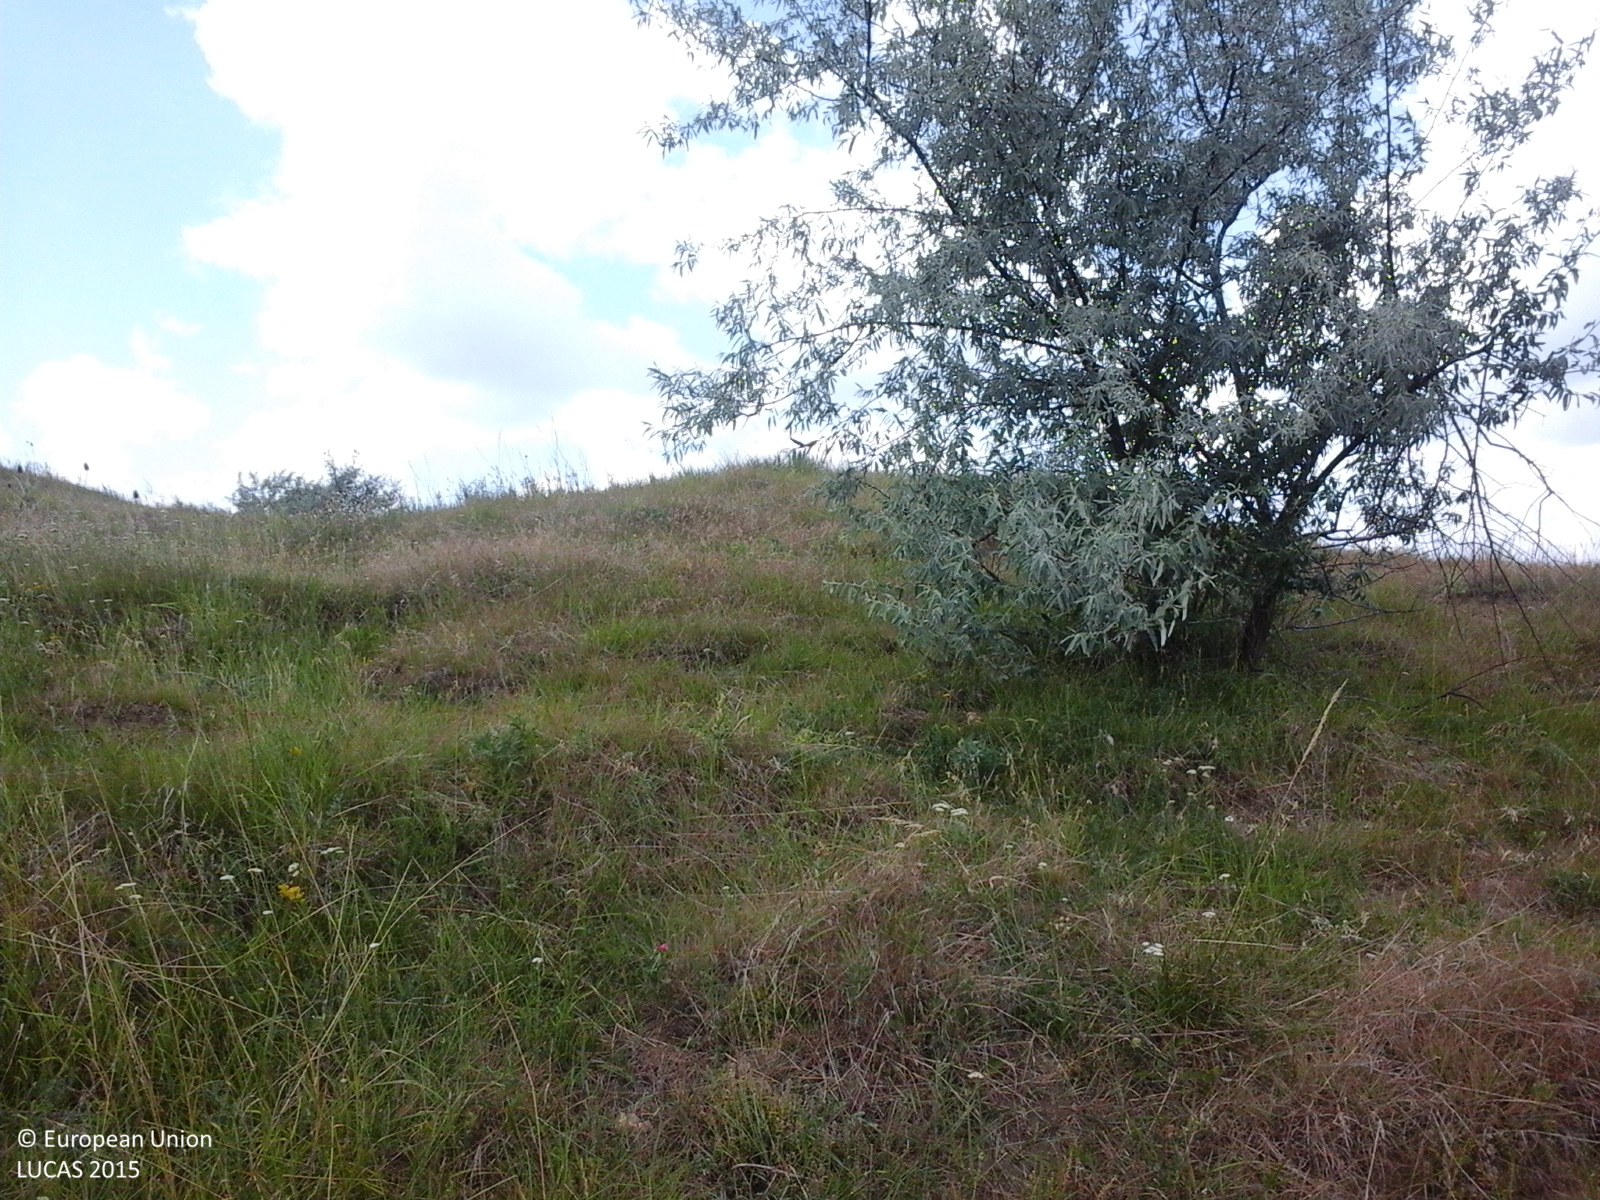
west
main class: Grassland
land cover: Grassland with sparse tree/shrub cover
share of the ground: > 75 %
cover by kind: herbaceous plants 90 %, broadleaved forest trees 5 %, shrubs 5 %
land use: Agriculture (excluding fallow land and kitchen gardens)
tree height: < 5 m
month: June
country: RO
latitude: 47.6712
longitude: 27.0605
